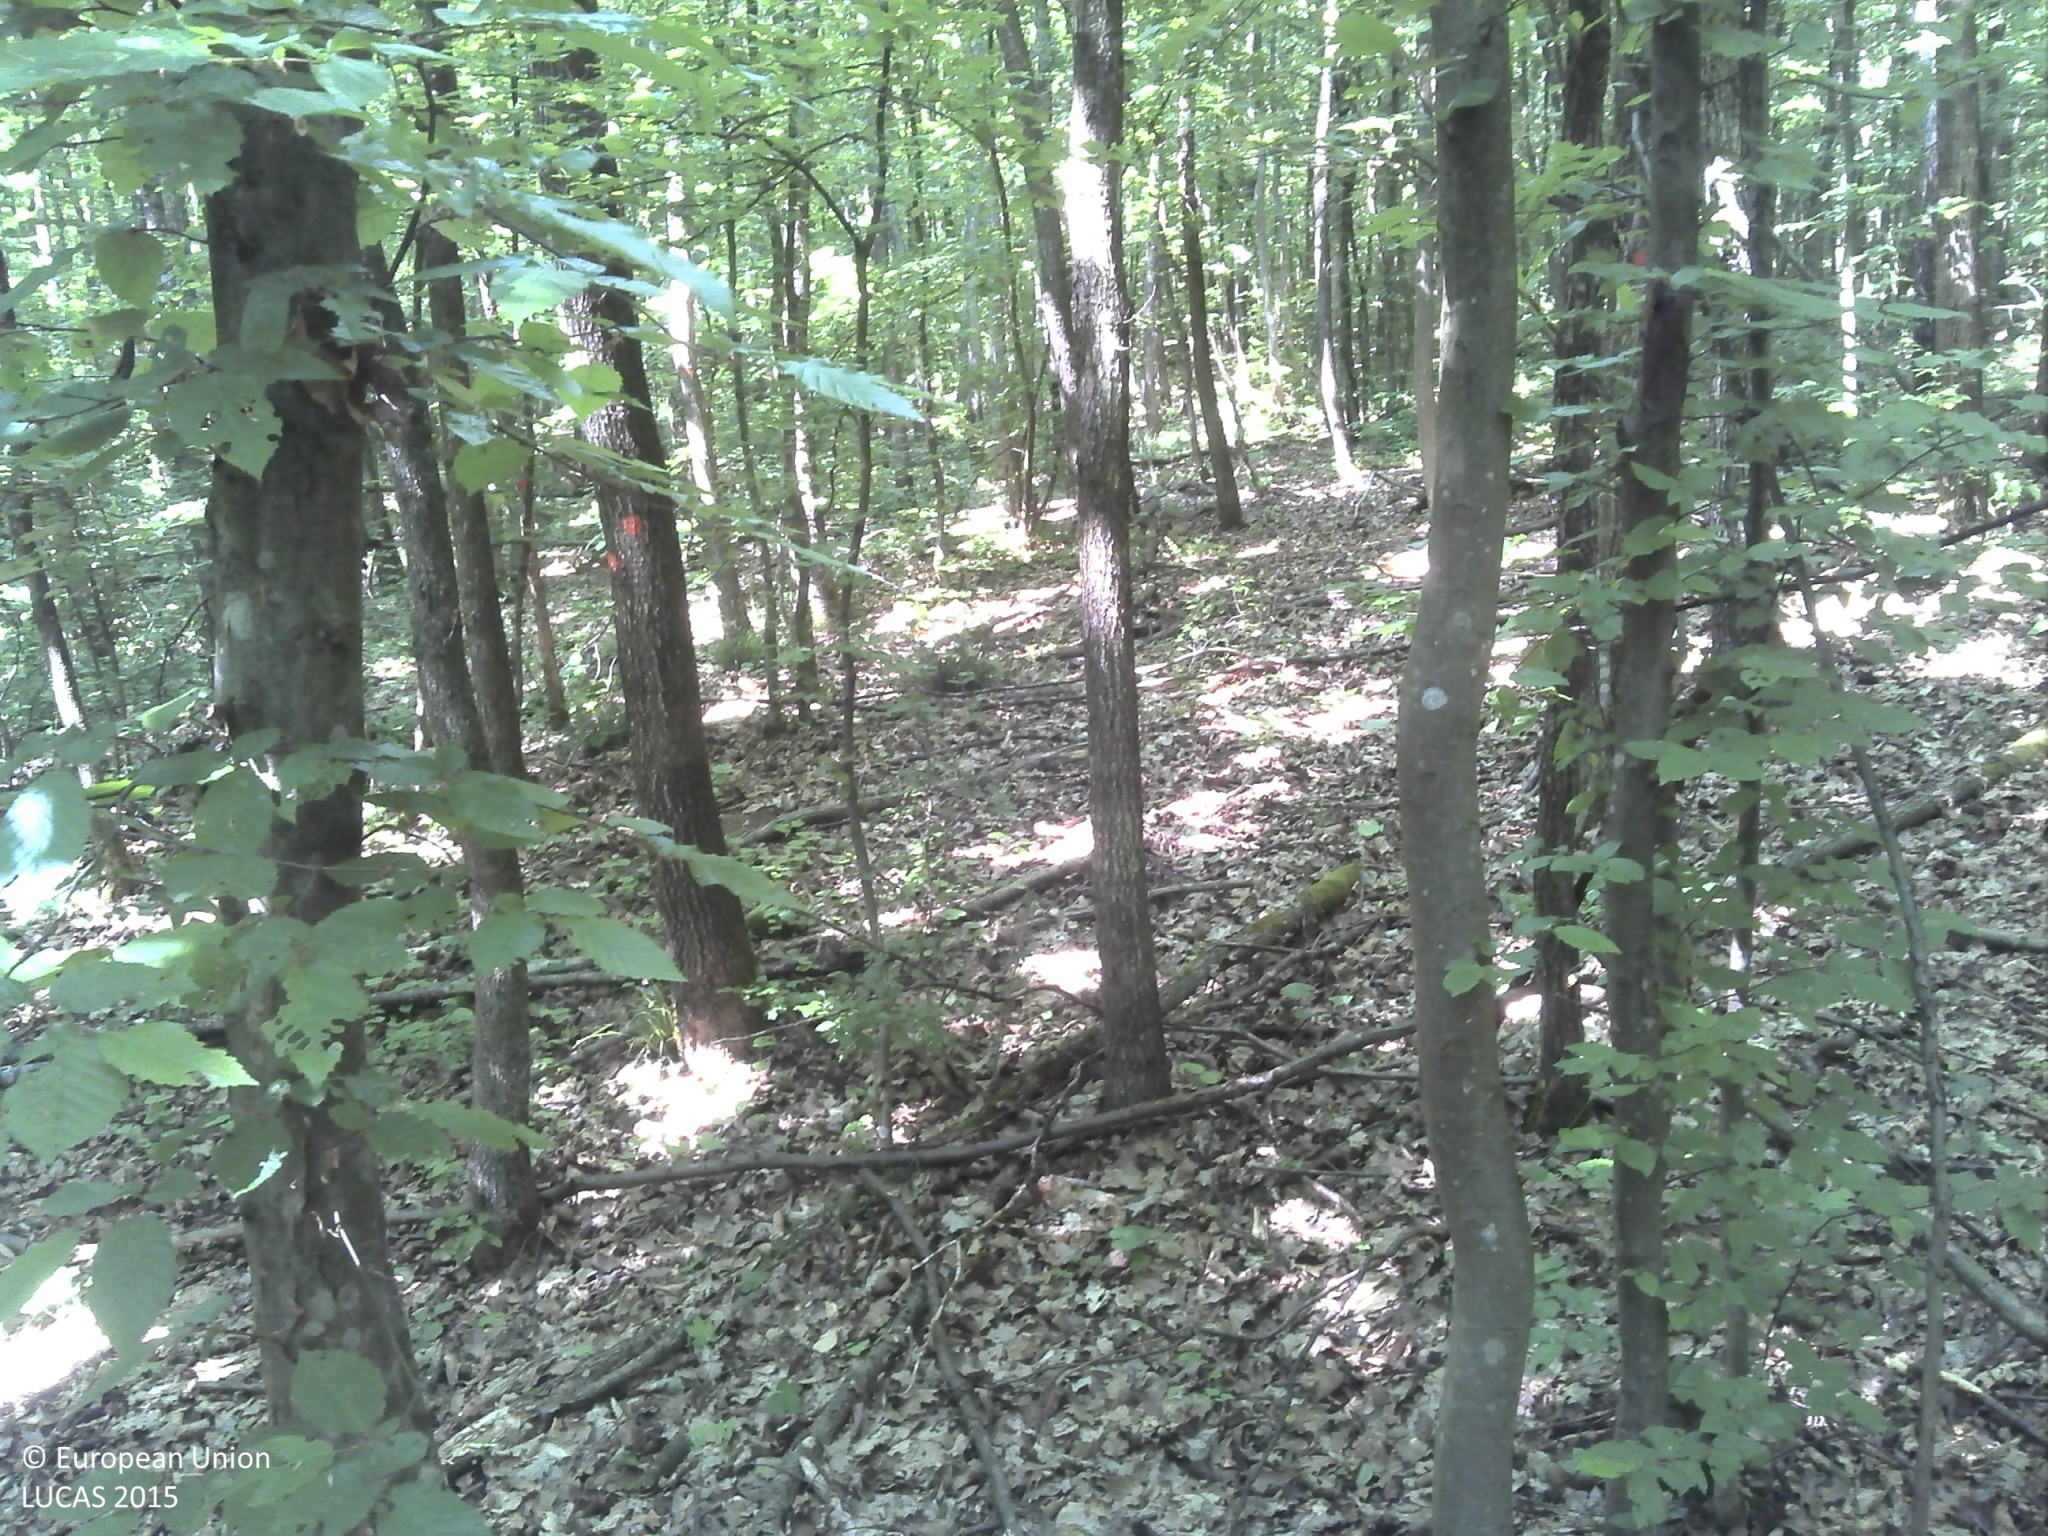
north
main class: Woodland
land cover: Broadleaved woodland
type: hemiboreal forest and nemoral coniferous forest and mixed broadleaved-coniferous forest
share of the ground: > 75 %
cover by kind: broadleaved forest trees 80 %, lichens and mosses 20 %
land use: Forestry
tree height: > 5 m
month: May
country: HR
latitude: 45.3094
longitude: 18.2309
